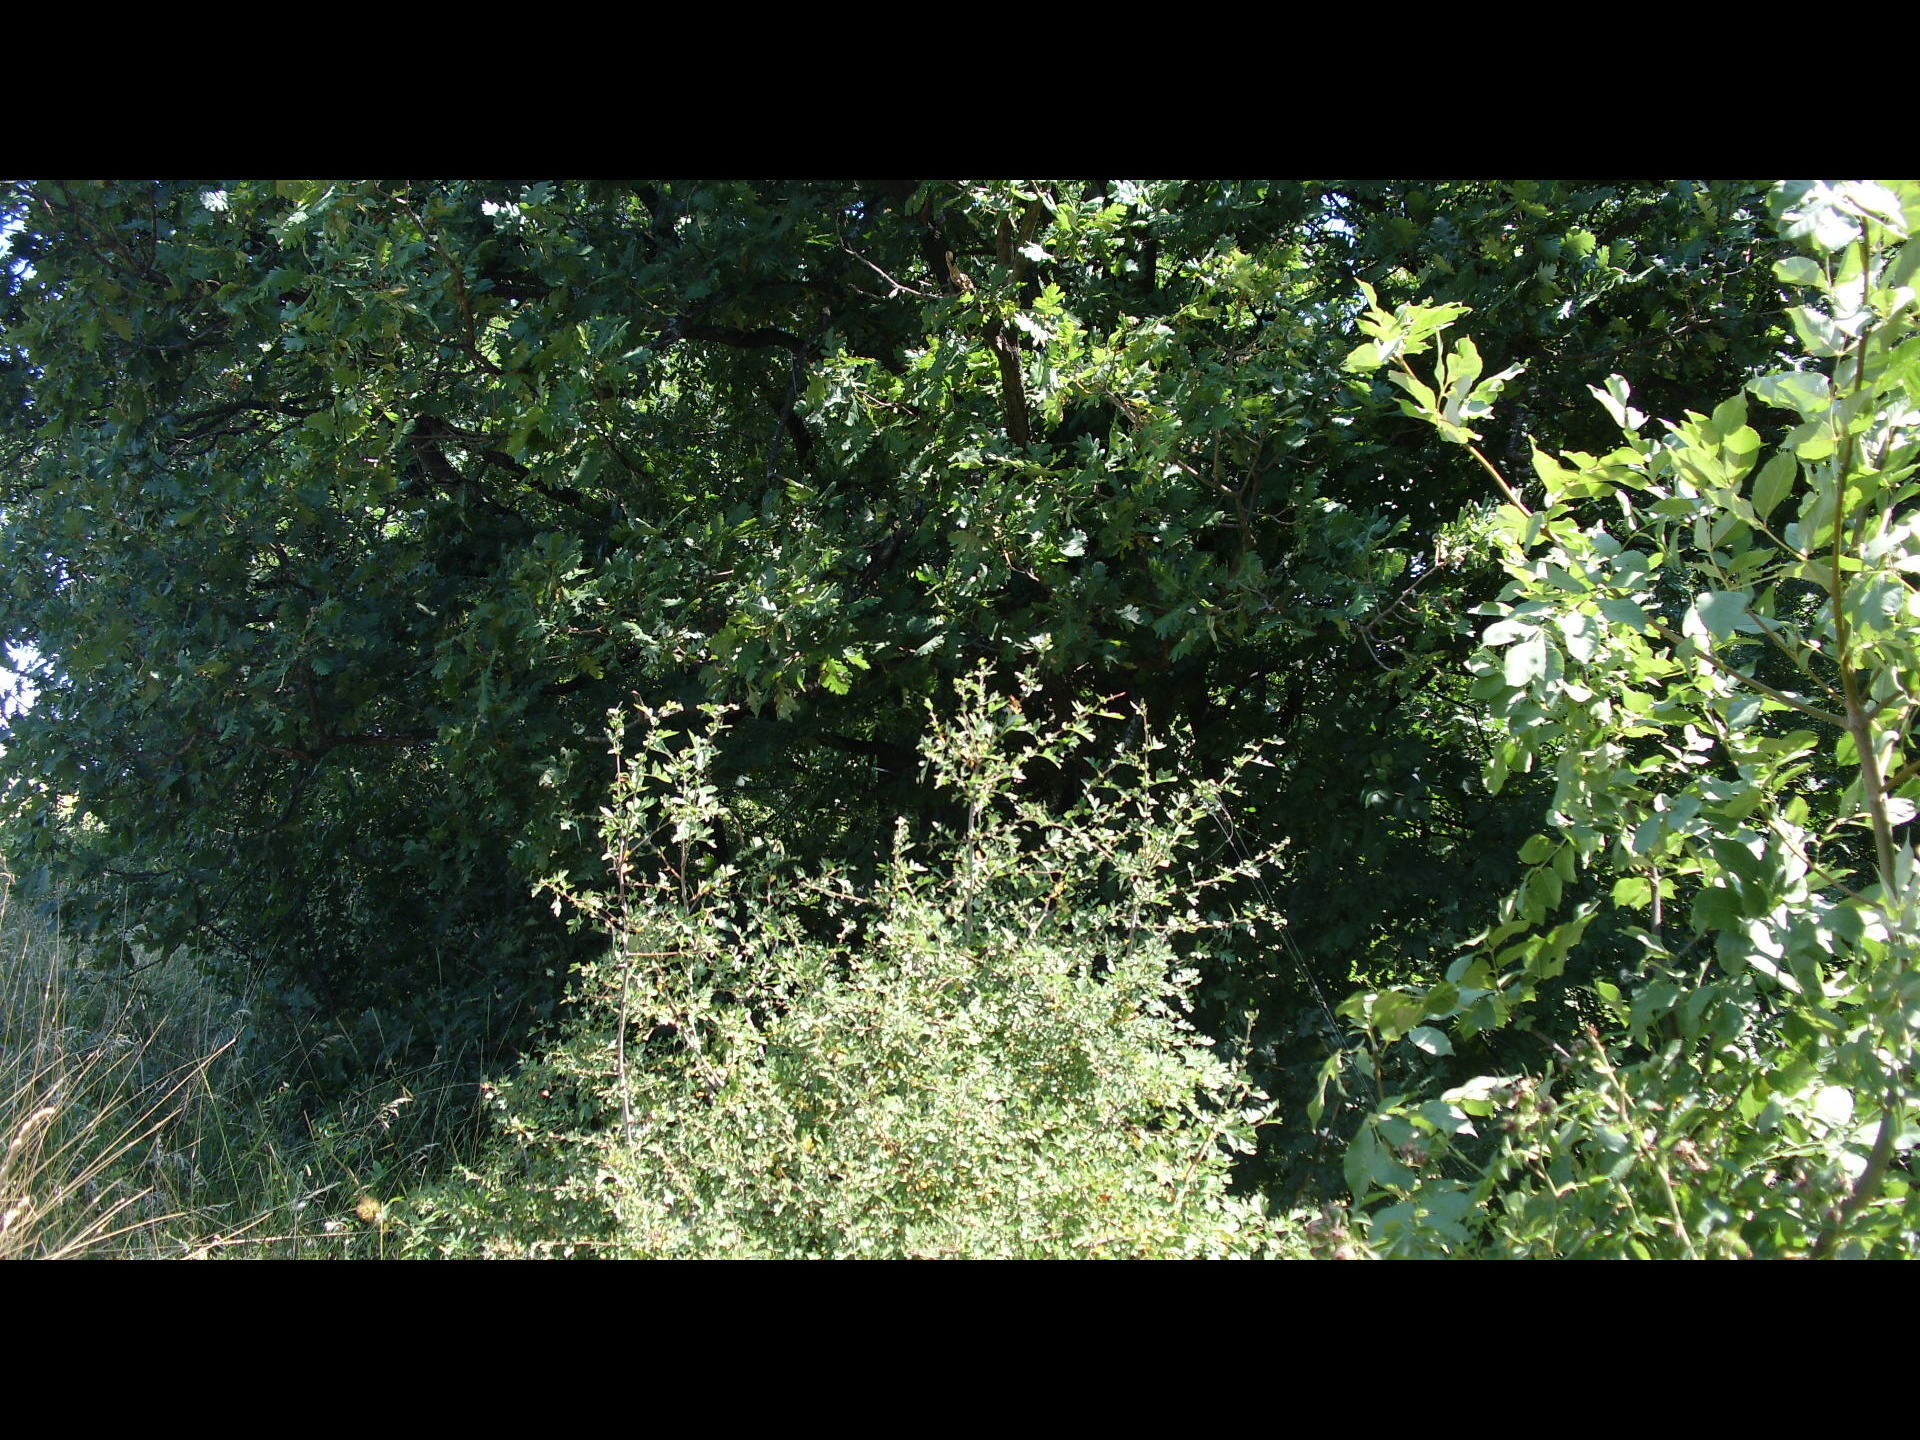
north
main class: Woodland
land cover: Broadleaved woodland
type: mesophytic deciduous forest
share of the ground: > 75 %
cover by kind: broadleaved forest trees 75 %, herbaceous plants 15 %, shrubs 10 %
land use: Forestry
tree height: > 5 m
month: July
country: BG
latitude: 43.7357
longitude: 22.6614
